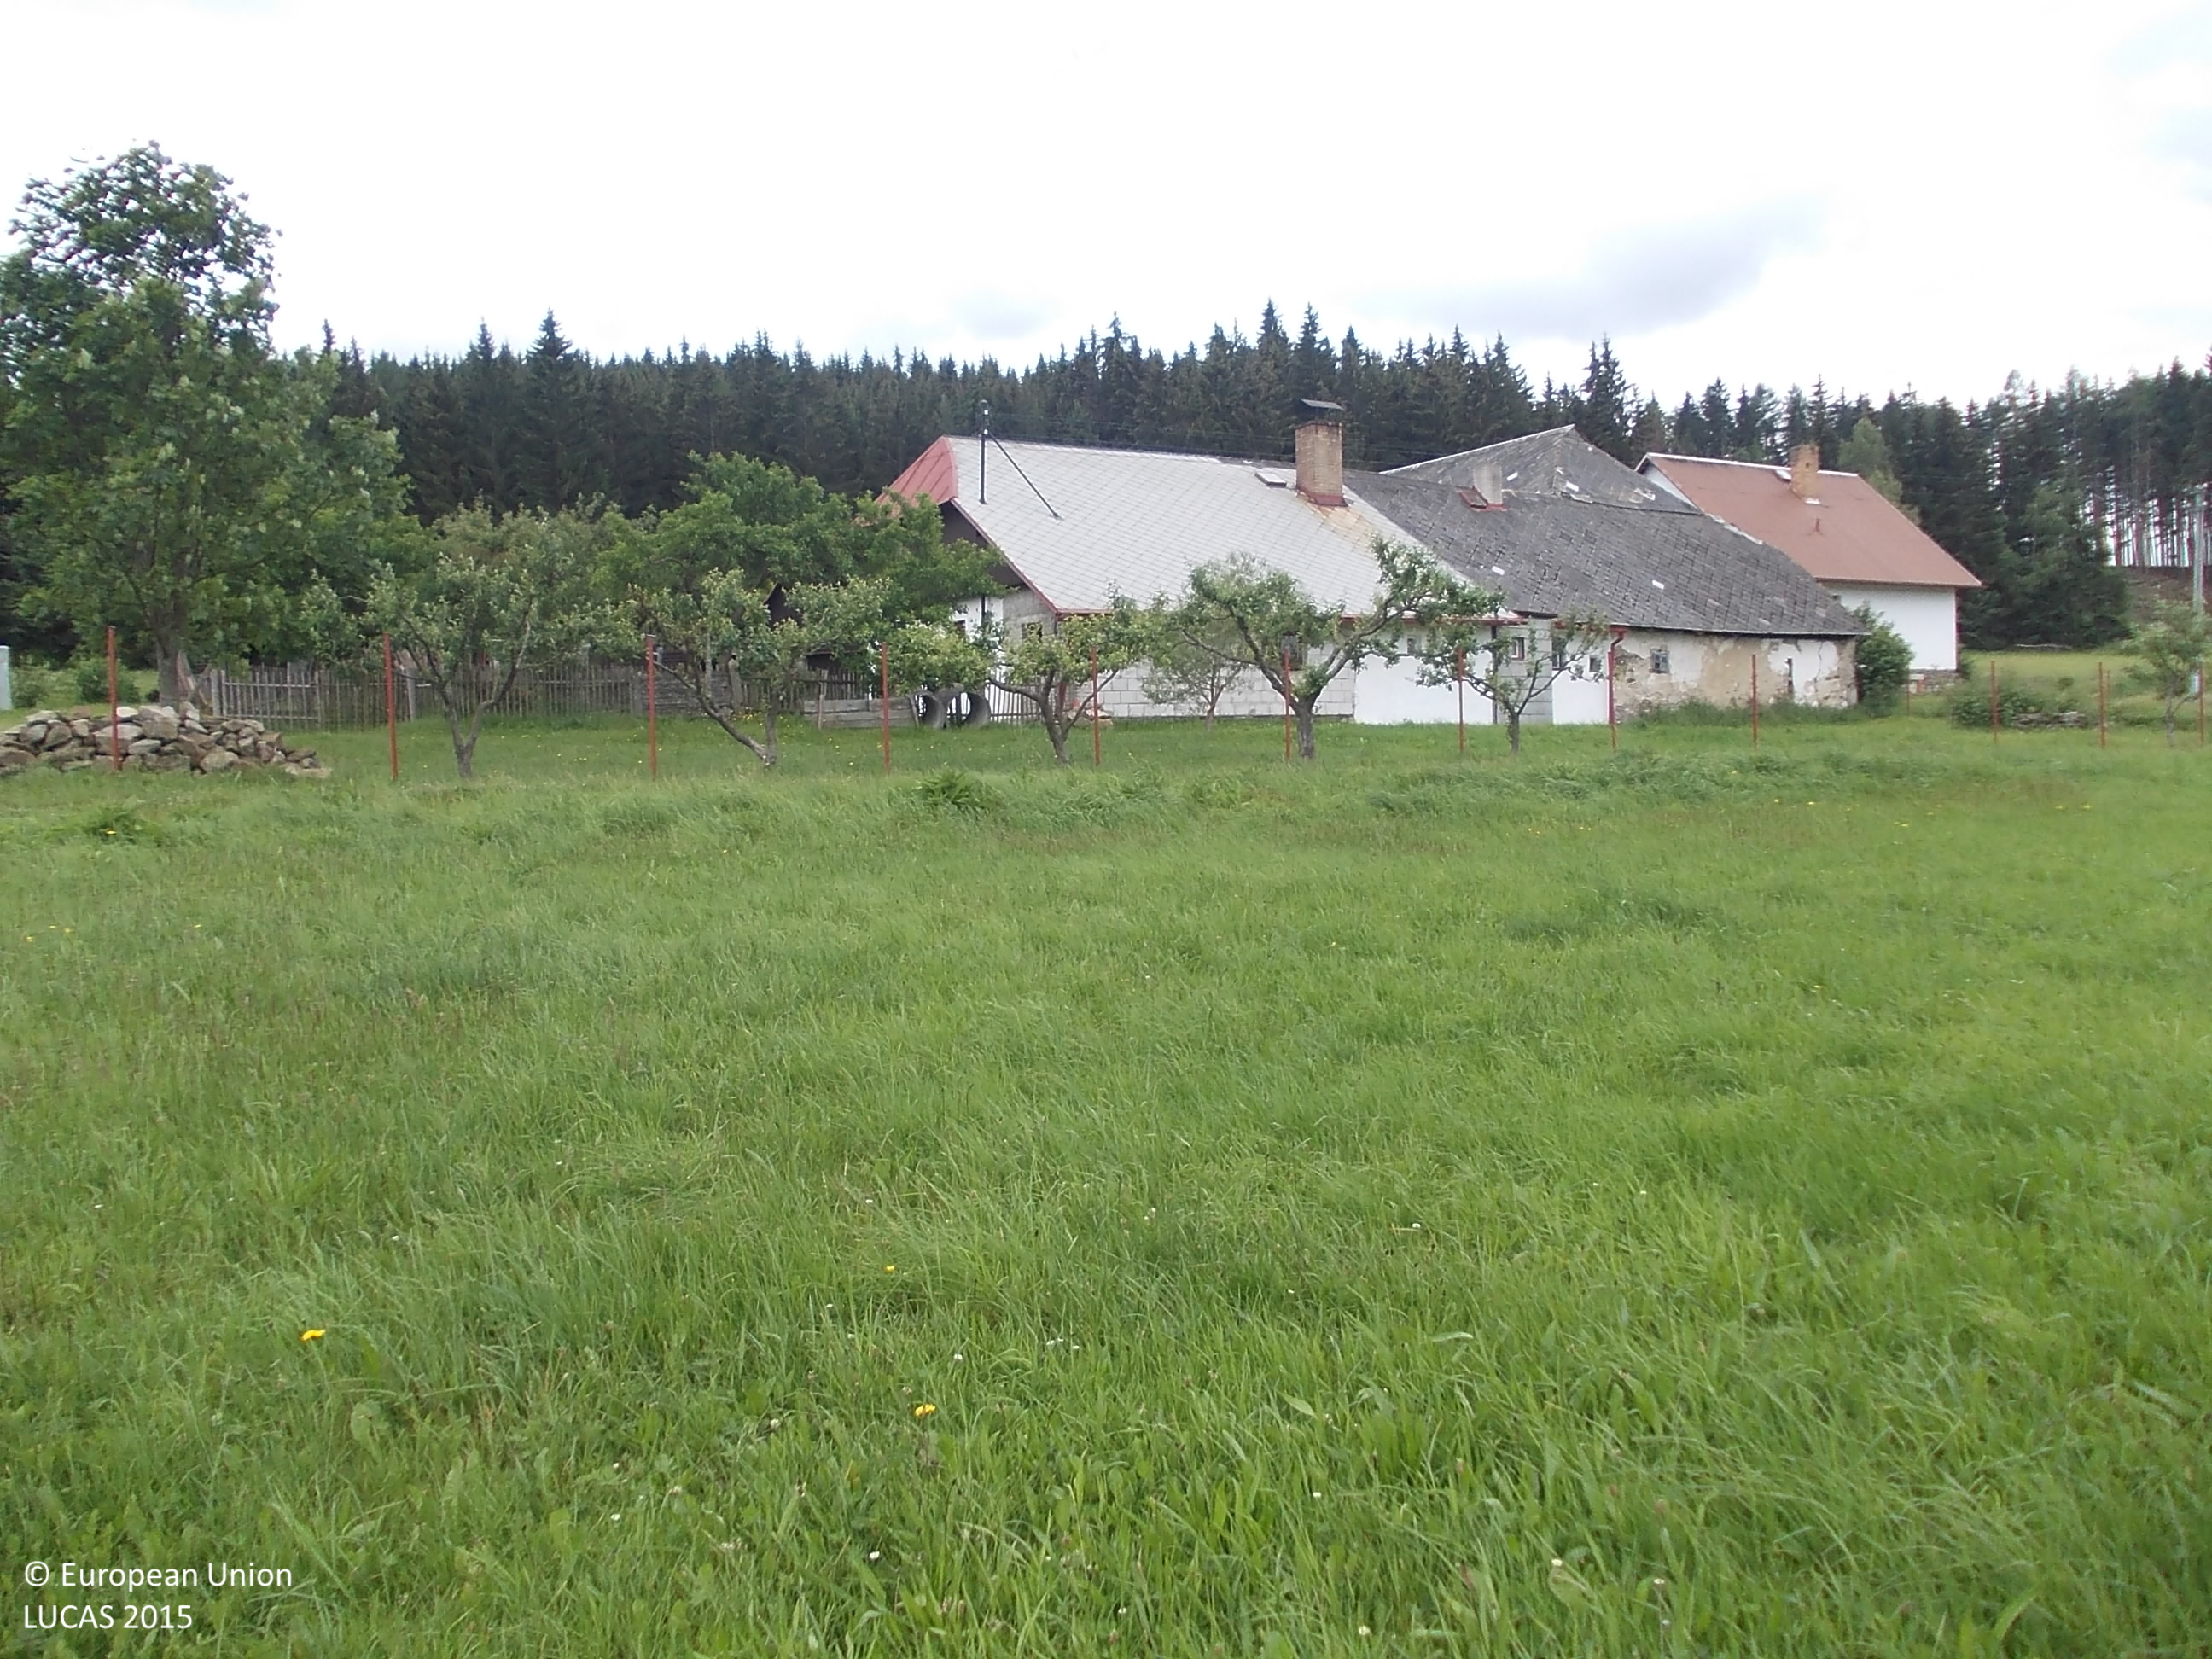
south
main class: Grassland
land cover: Grassland without tree/shrub cover
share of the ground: > 75 %
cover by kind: herbaceous plants 100 %
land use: Agriculture (excluding fallow land and kitchen gardens)
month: June
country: CZ
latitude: 49.0797
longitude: 13.7103
